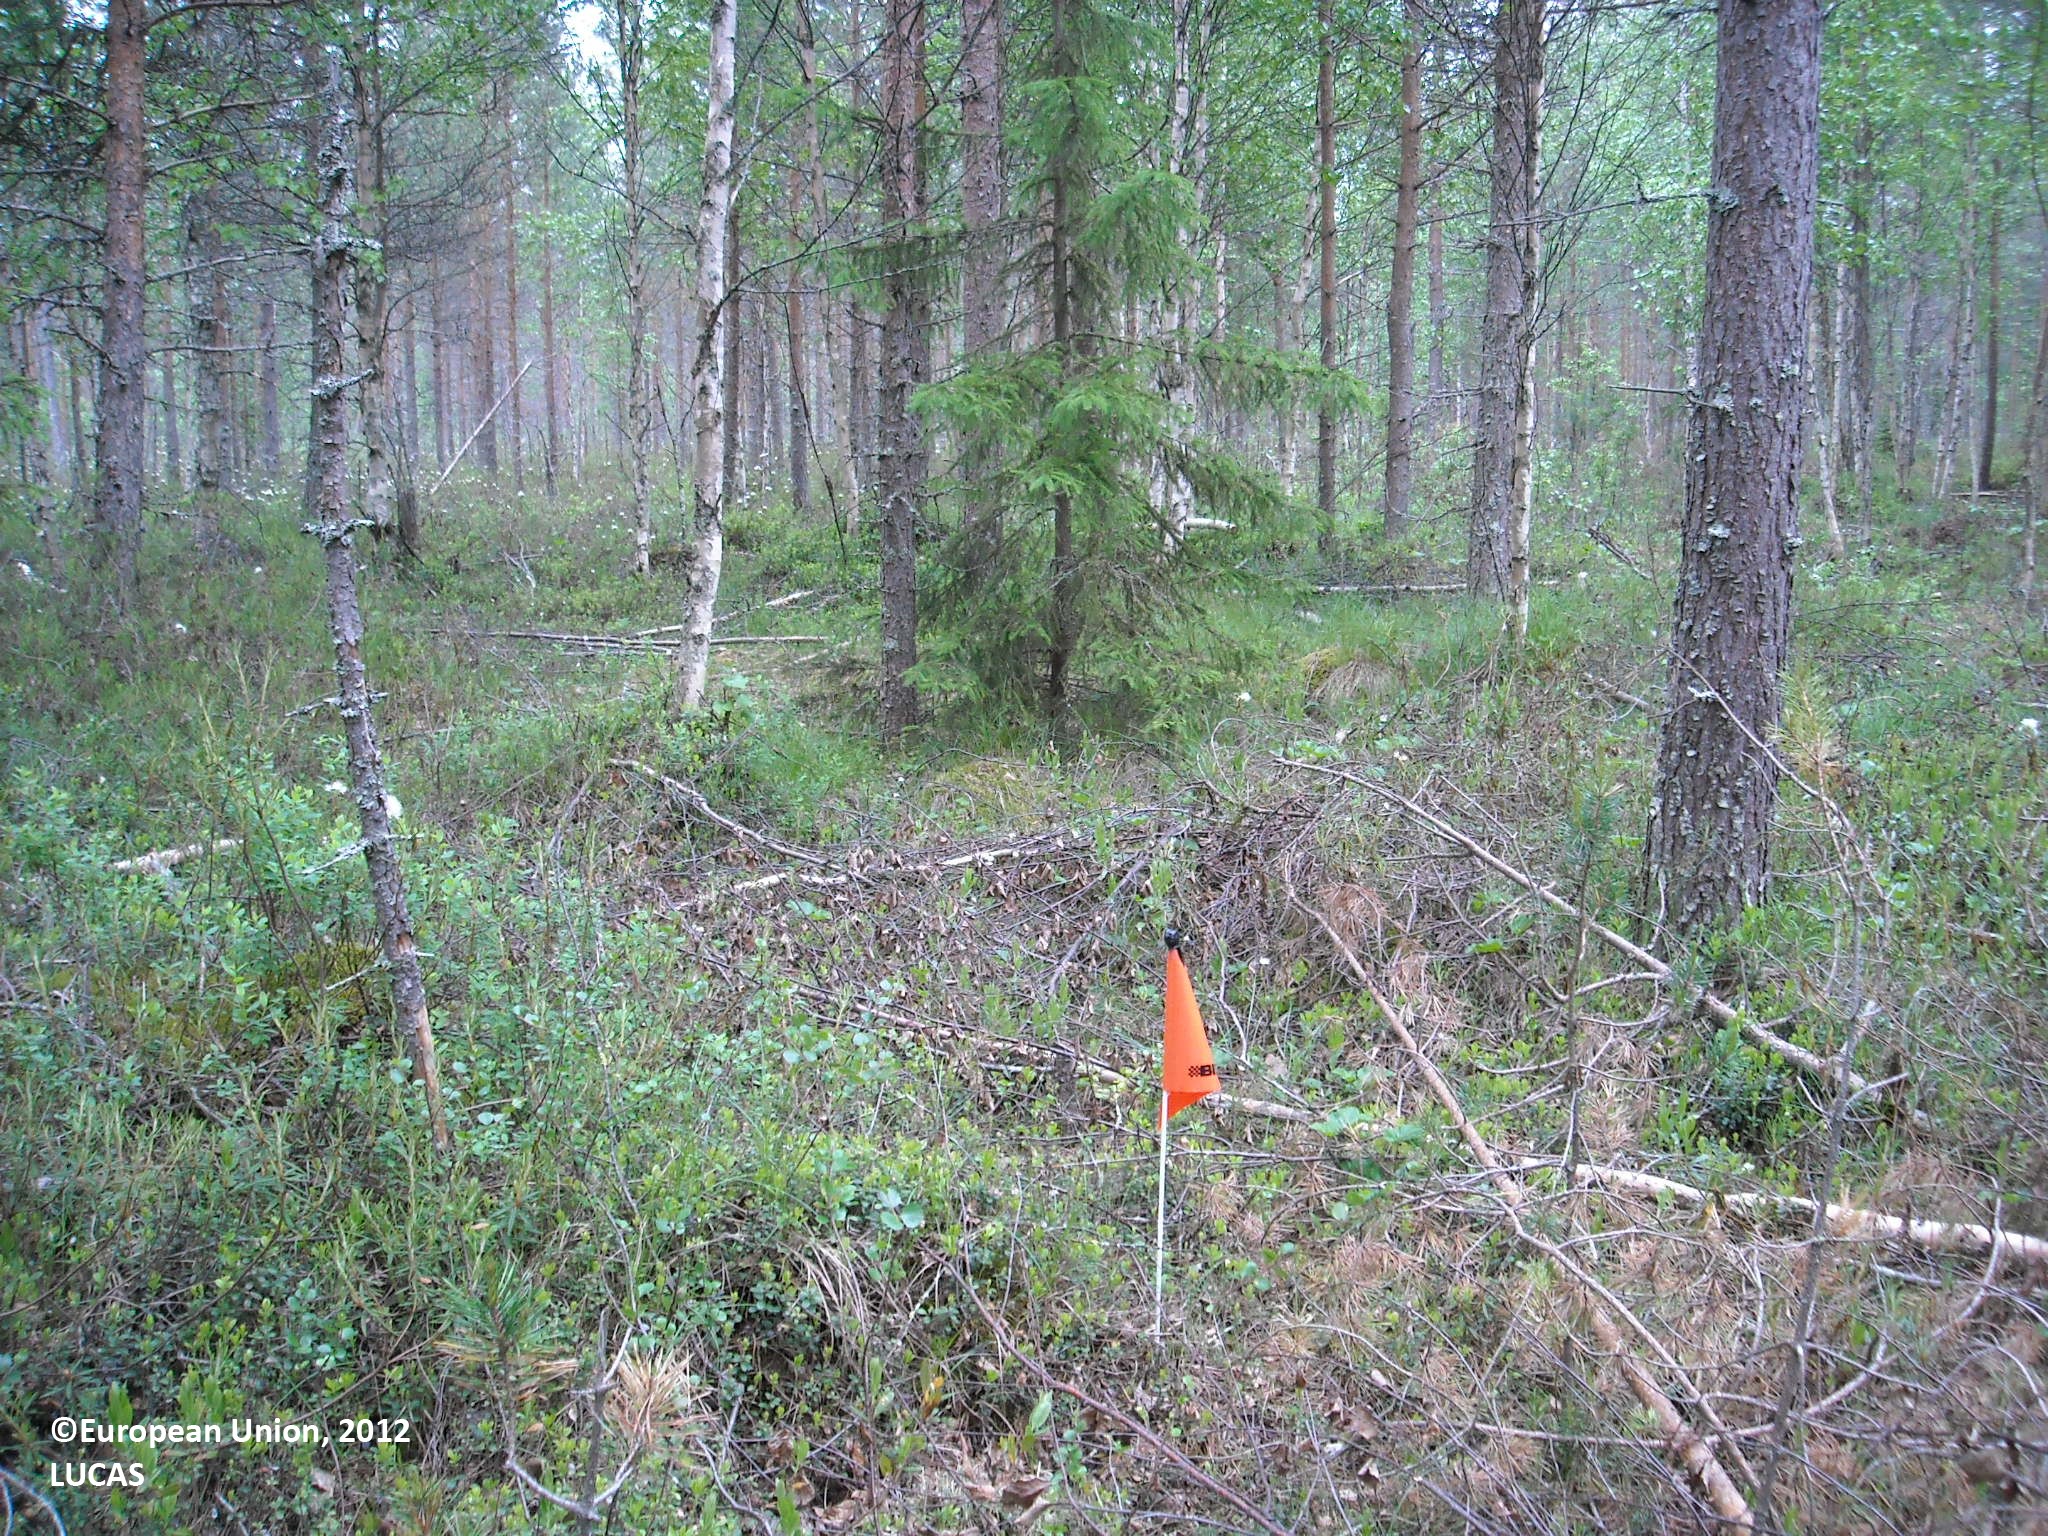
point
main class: Woodland
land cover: Pine dominated mixed woodland
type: mire and swamp forests
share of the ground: > 75 %
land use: Forestry
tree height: > 5 m
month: June
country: FI
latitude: 64.4866
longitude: 27.2185
